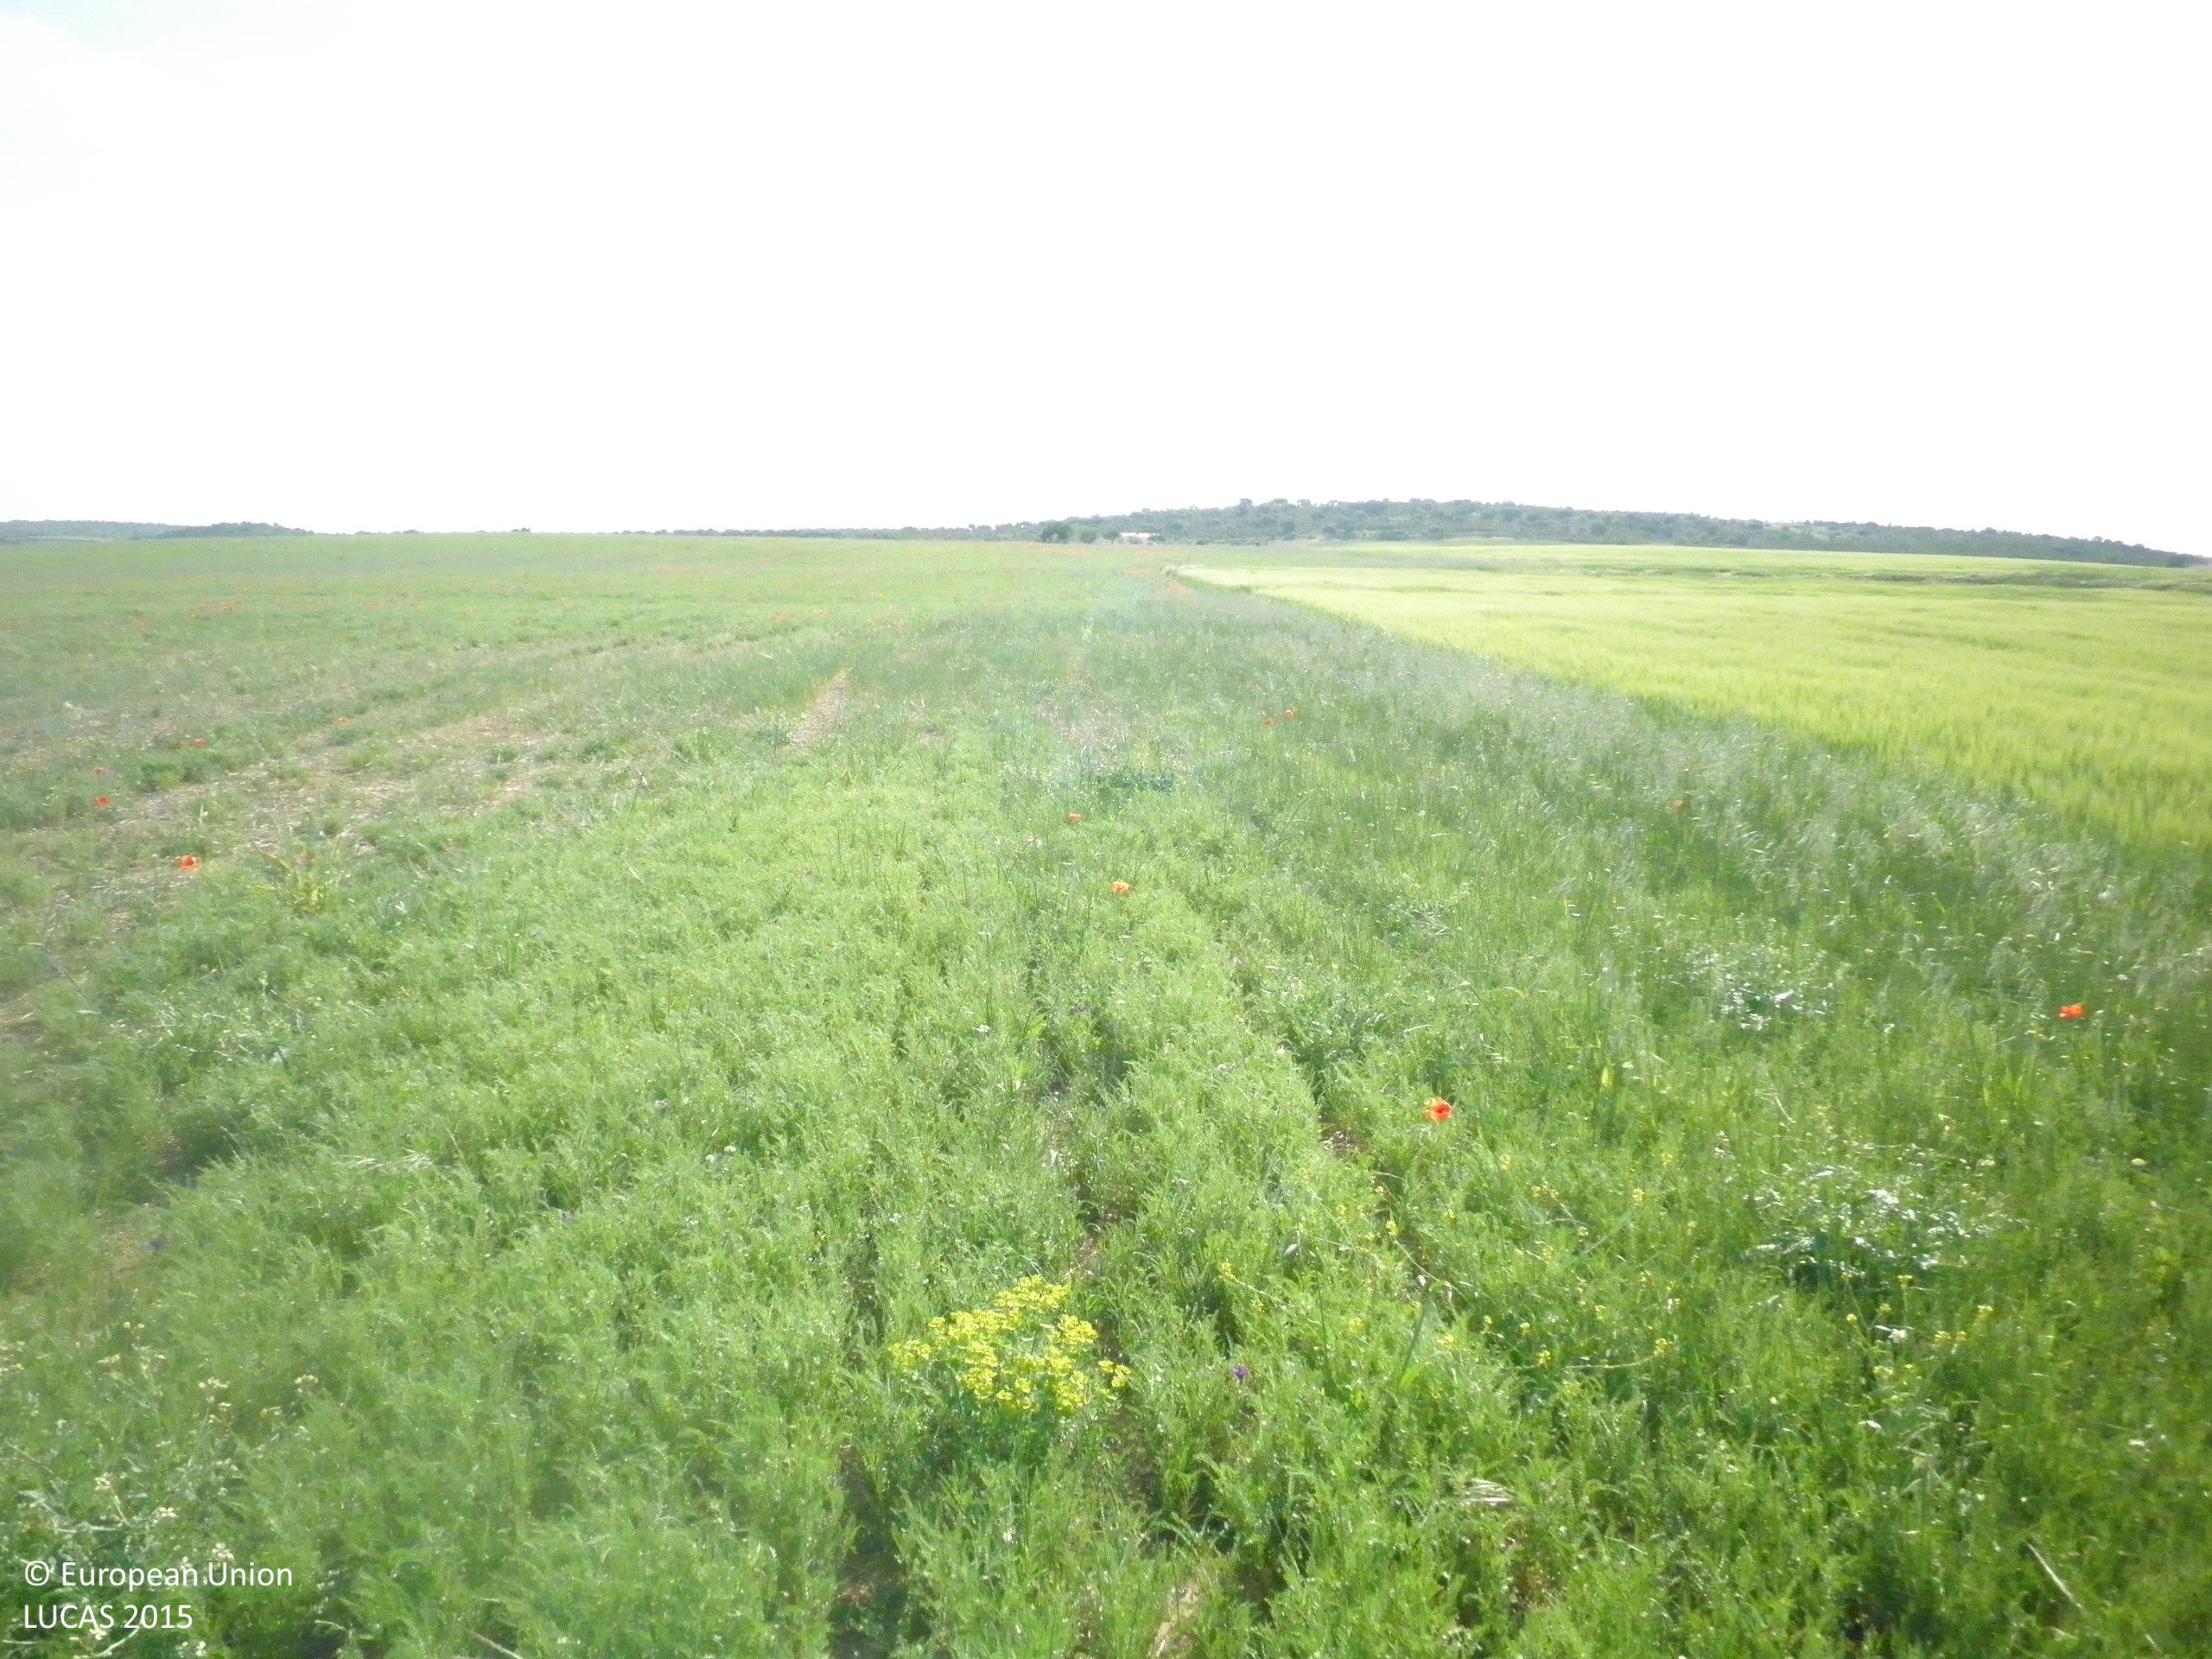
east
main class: Cropland
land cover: Dry pulses
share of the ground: > 75 %
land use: Agriculture (excluding fallow land and kitchen gardens)
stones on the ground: < 10 %
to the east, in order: Dry pulses; Barley; Dry pulses; Barley
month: May
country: ES
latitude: 39.6241
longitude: -2.6786
